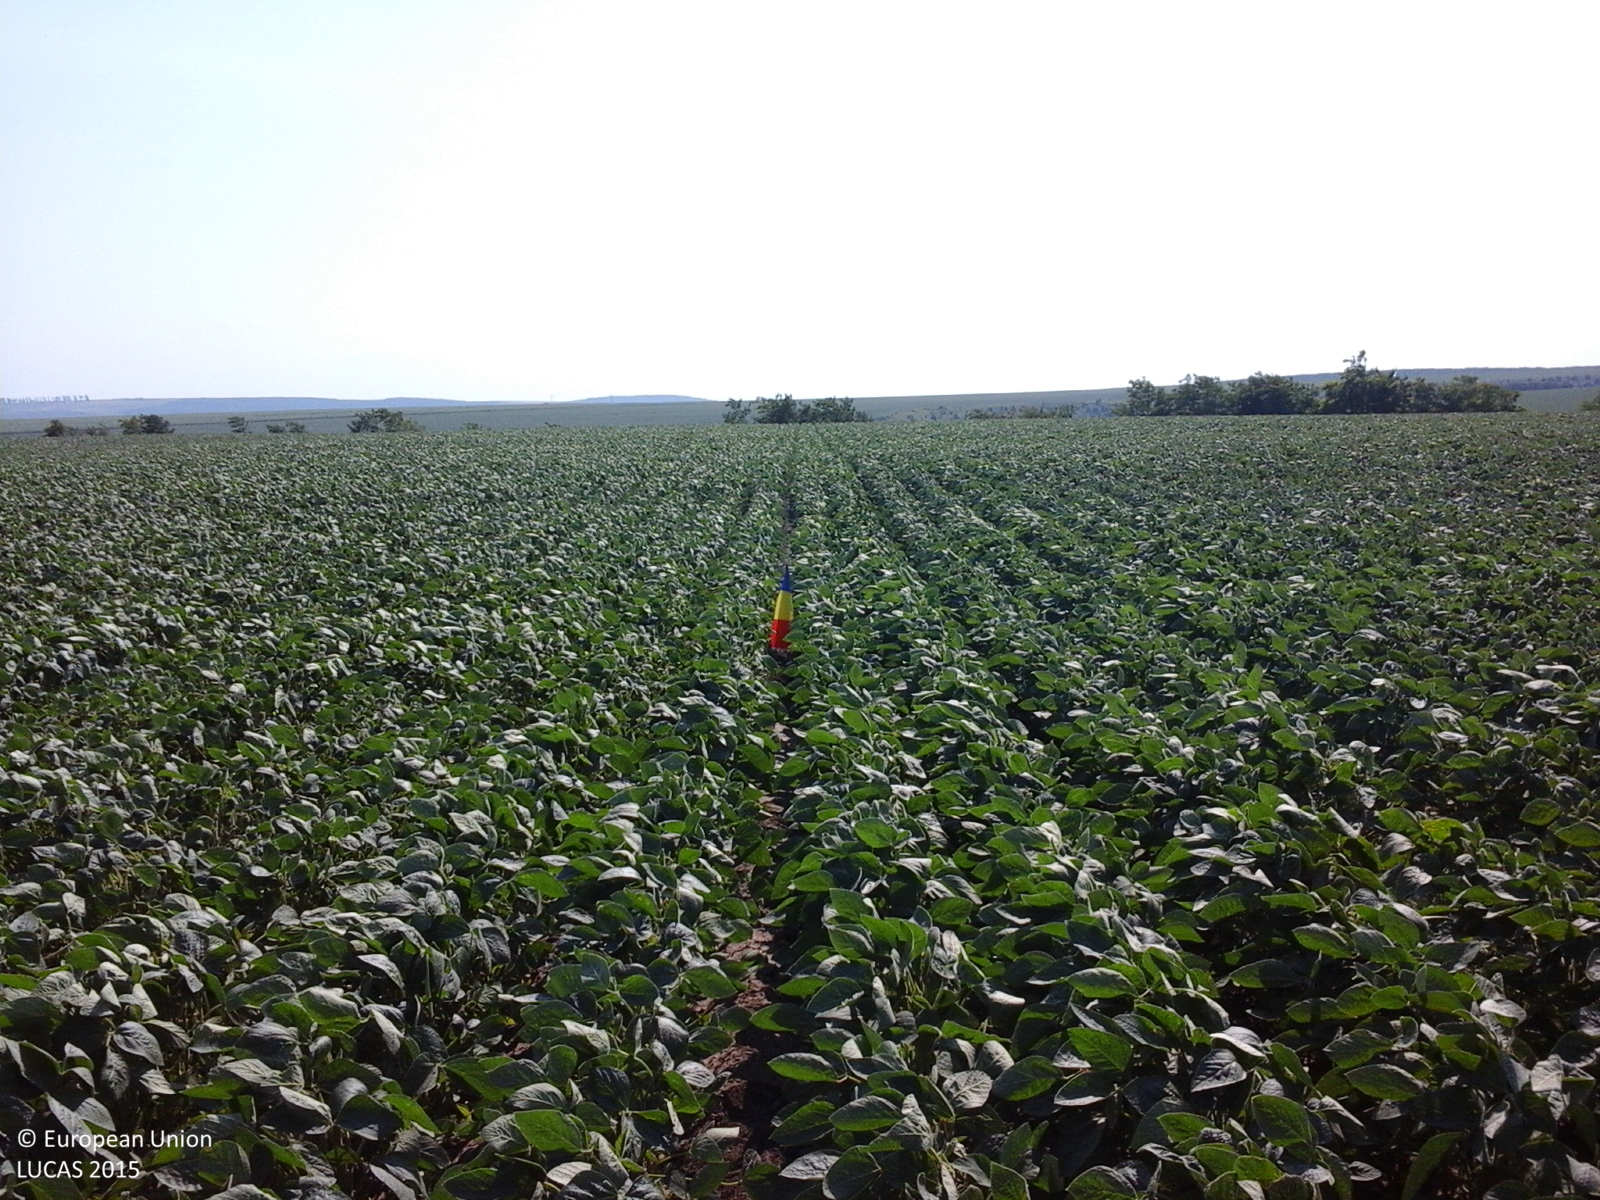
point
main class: Cropland
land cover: Soya
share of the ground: > 75 %
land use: Agriculture (excluding fallow land and kitchen gardens)
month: June
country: RO
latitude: 47.3477
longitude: 27.4701
